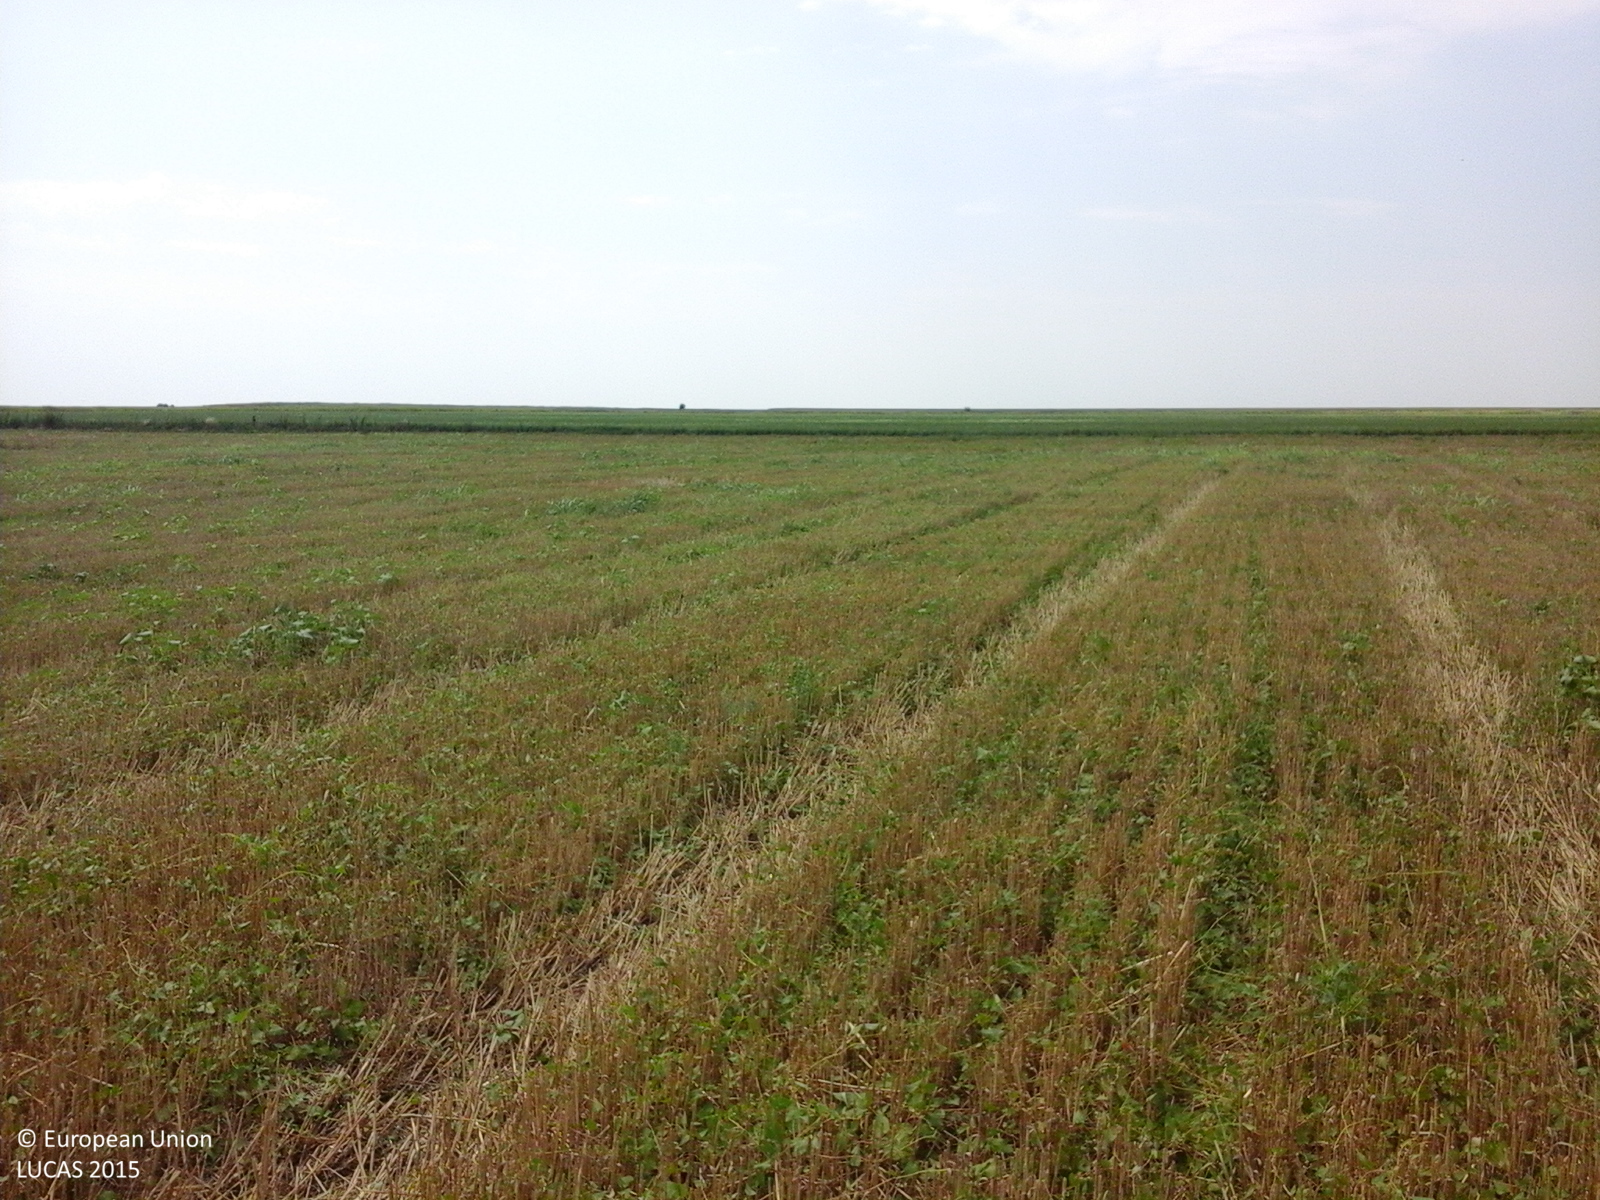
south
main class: Cropland
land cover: Durum wheat
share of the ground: 10 - 25 %
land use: Agriculture (excluding fallow land and kitchen gardens)
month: July
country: RO
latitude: 44.7386
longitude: 26.8865
